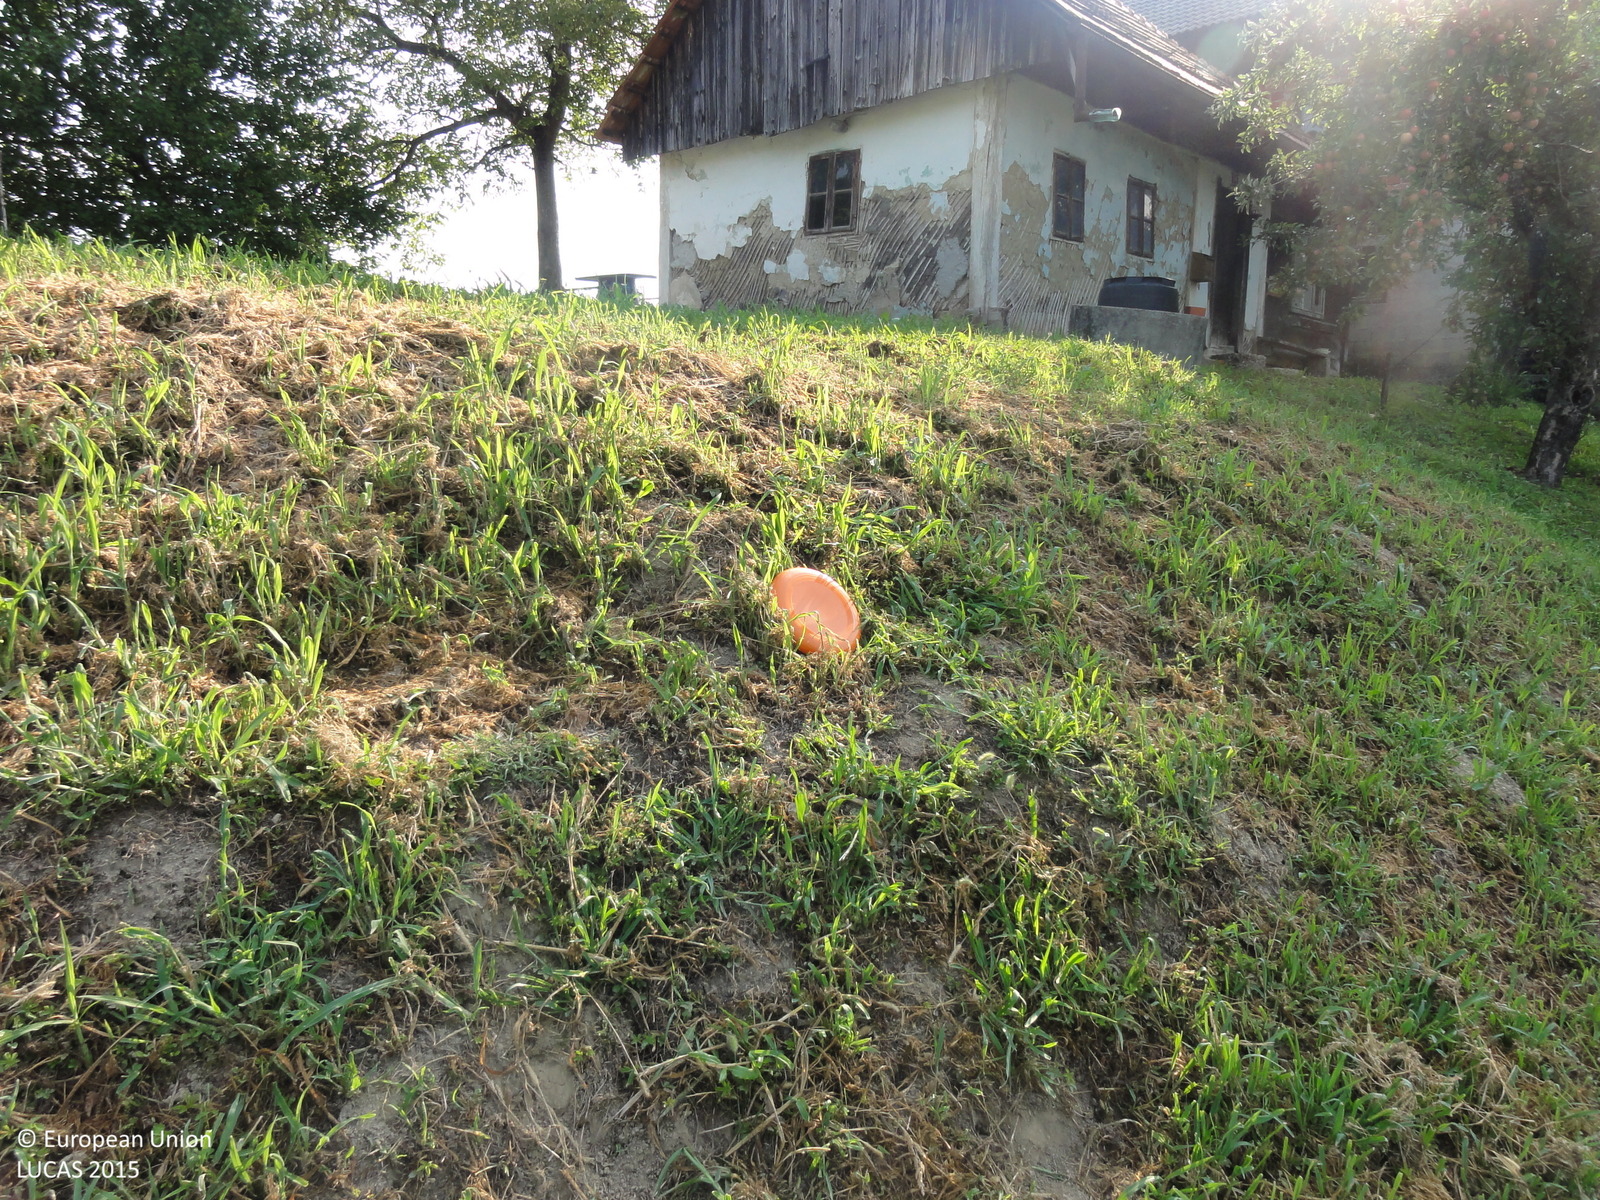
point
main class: Grassland
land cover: Grassland without tree/shrub cover
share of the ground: > 75 %
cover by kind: herbaceous plants 100 %
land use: Agriculture (excluding fallow land and kitchen gardens)
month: August
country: SI
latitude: 46.0024
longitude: 15.6666
